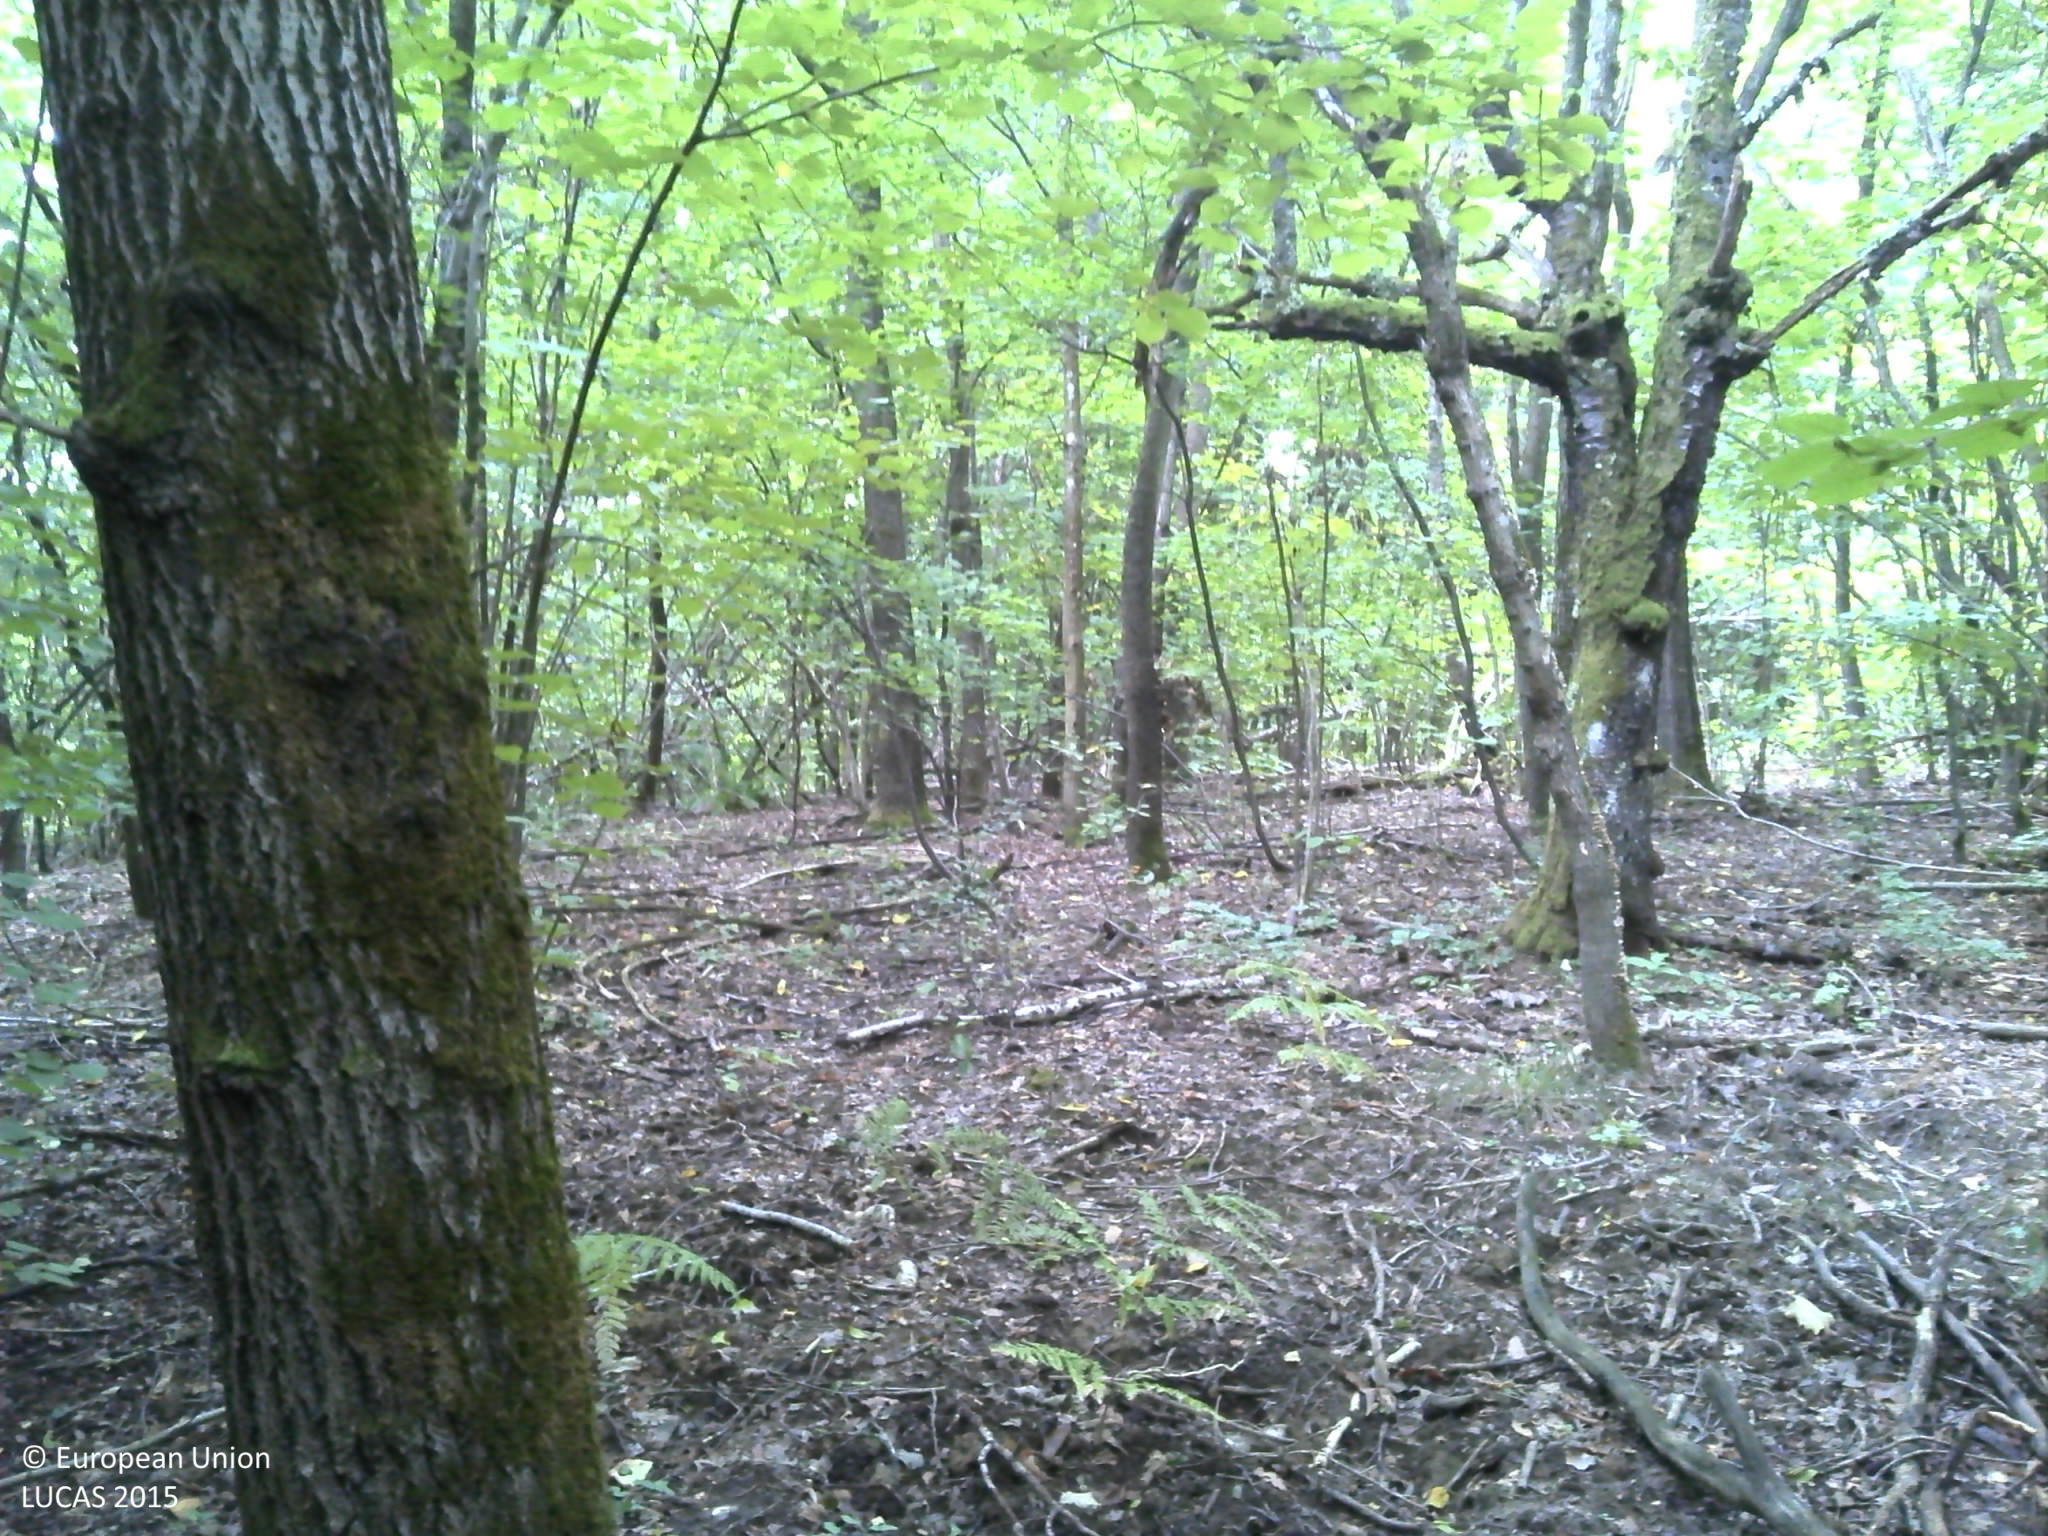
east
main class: Woodland
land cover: Broadleaved woodland
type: acidophilous oak and oak-birch forest
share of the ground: > 75 %
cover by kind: broadleaved forest trees 100 %
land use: Forestry
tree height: > 5 m
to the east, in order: Broadleaved woodland
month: August
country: HR
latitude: 45.2234
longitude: 16.6328
